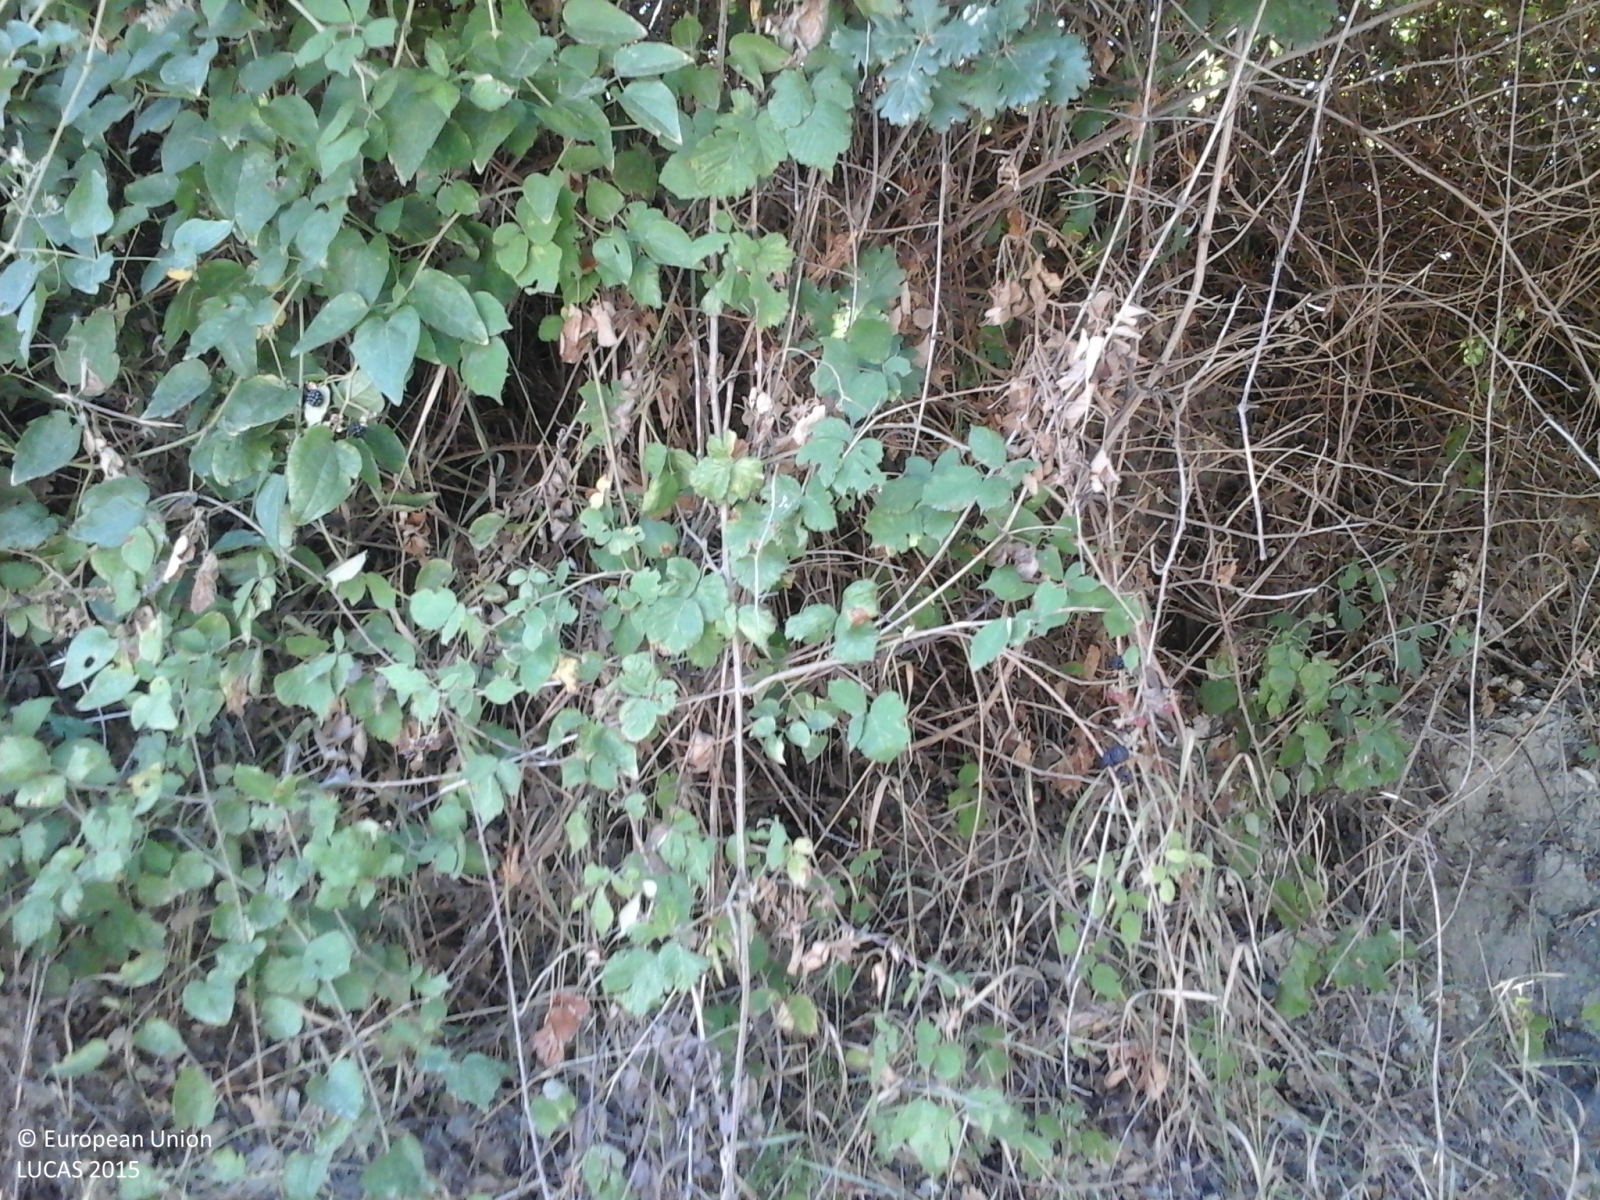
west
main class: Shrubland
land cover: Shrubland with sparse tree cover
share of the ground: > 75 %
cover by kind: shrubs 95 %, broadleaved forest trees 5 %
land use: Semi-natural and natural areas not in use
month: August
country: IT
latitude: 43.7388
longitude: 12.6630
